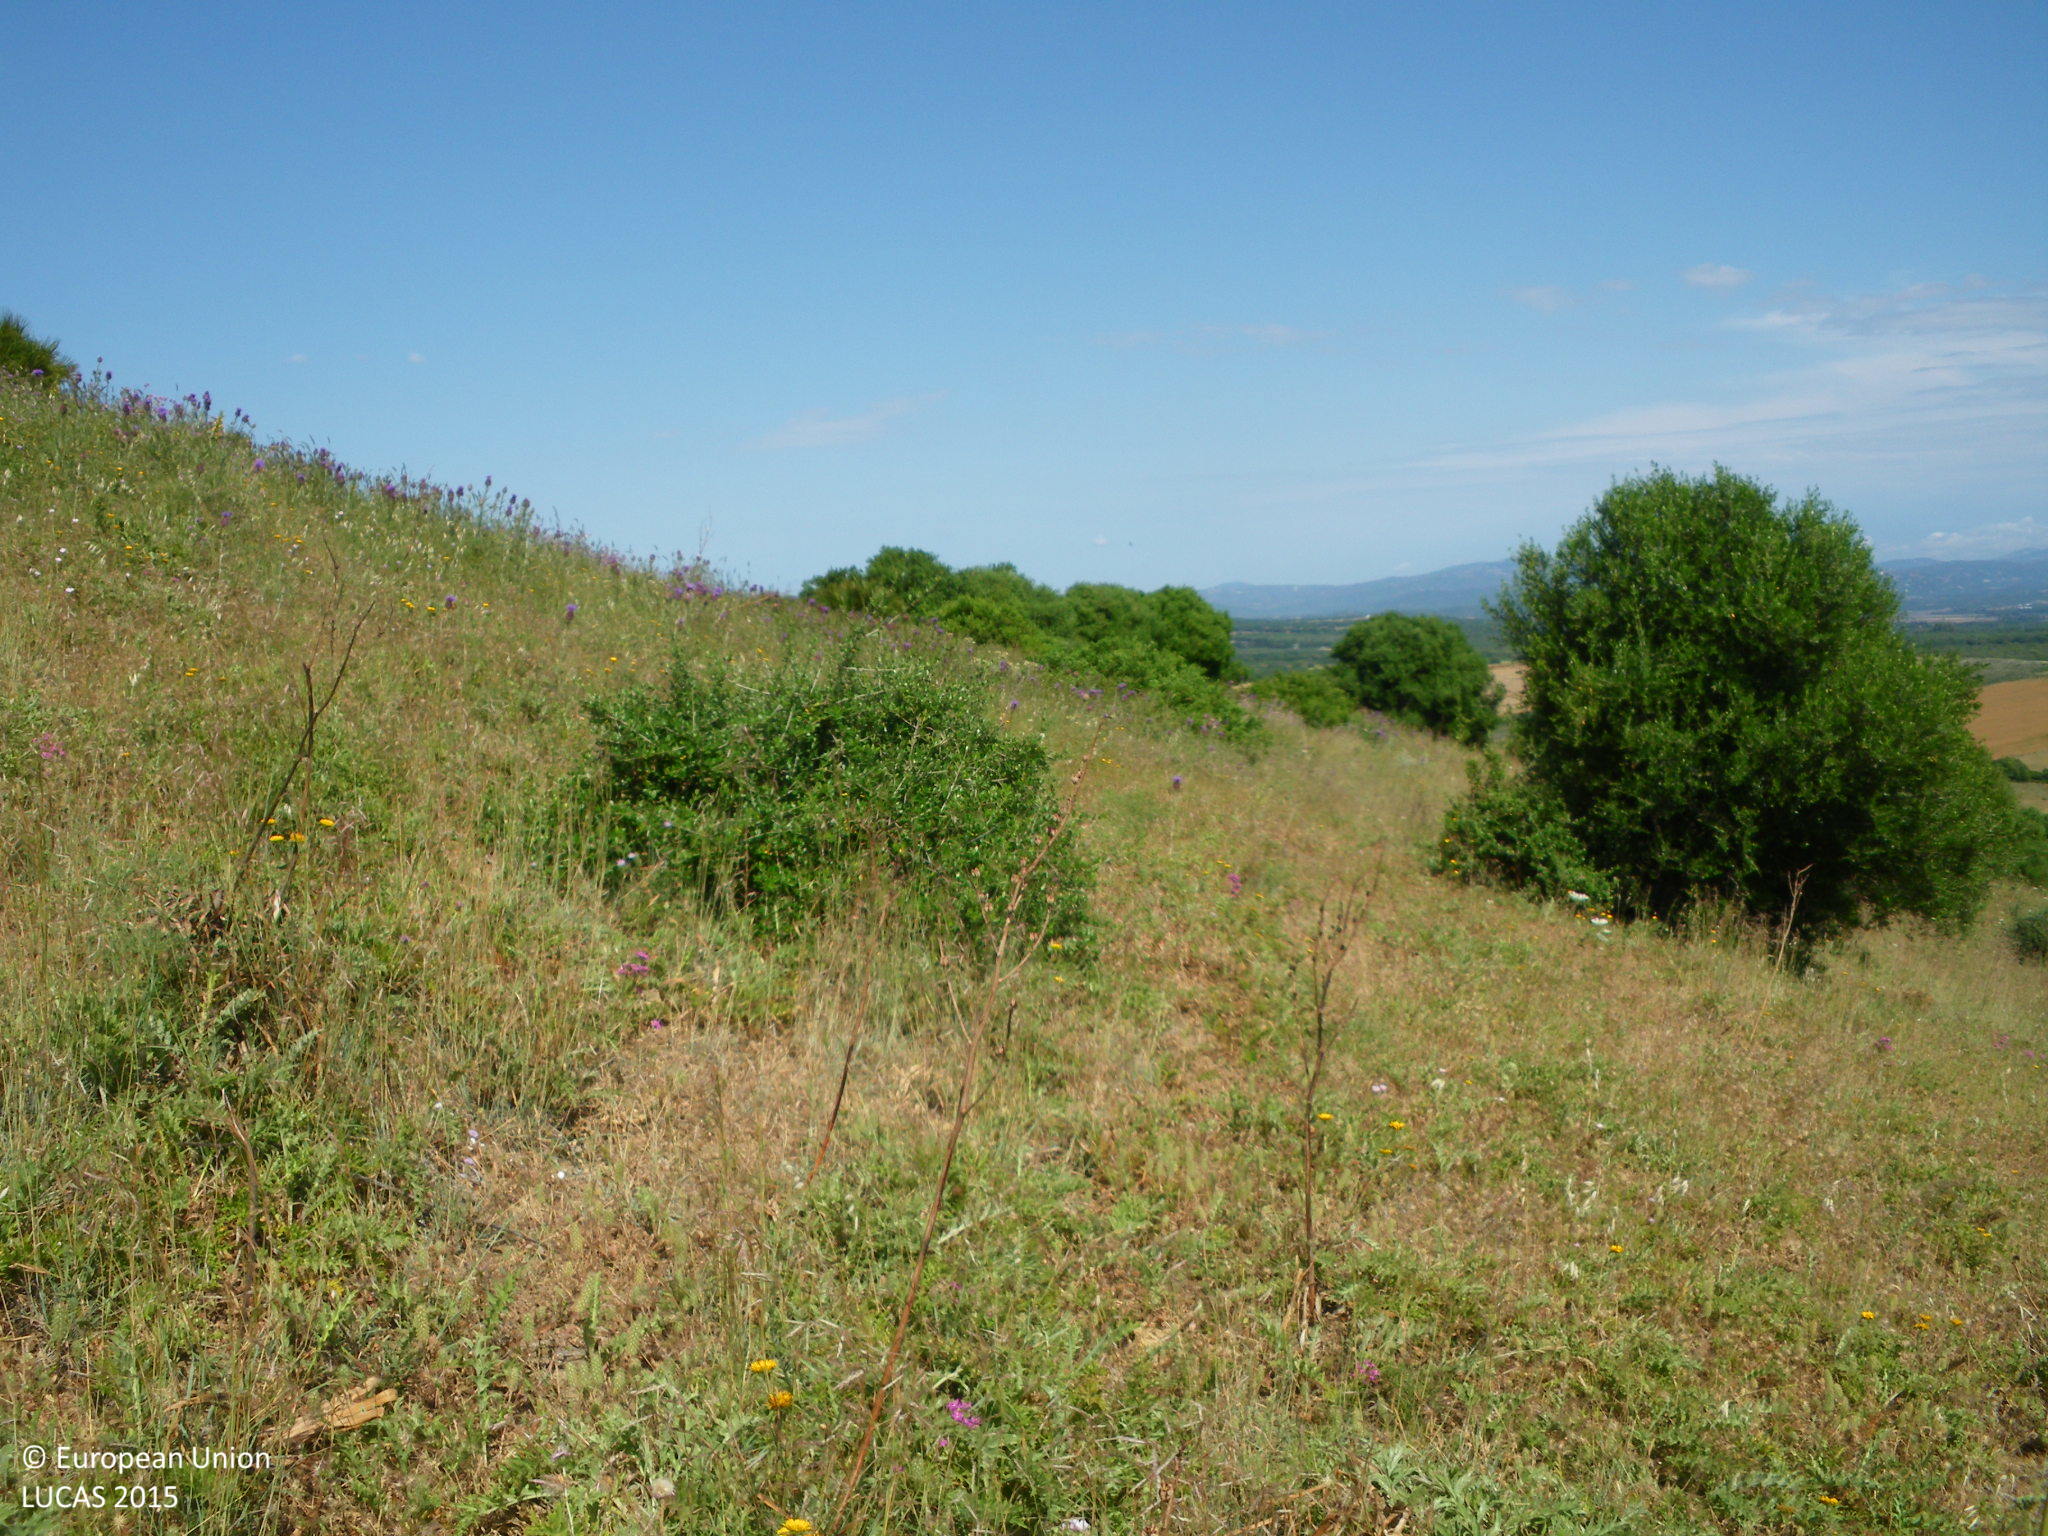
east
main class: Woodland
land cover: Broadleaved woodland
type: broadleaved evergreen forest
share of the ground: 10 - 25 %
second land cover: Grassland without tree/shrub cover
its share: > 75 %
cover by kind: herbaceous plants 80 %, broadleaved forest trees 10 %, shrubs 5 %, unconsolidated bare surface 5 %
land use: Forestry
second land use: Agriculture (excluding fallow land and kitchen gardens)
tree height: < 5 m
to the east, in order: Broadleaved woodland; Grassland without tree/shrub cover; Shrubland with sparse tree cover; Broadleaved woodland; Fences; Grassland without tree/shrub cover
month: May
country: ES
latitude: 36.3449
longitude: -5.9016
